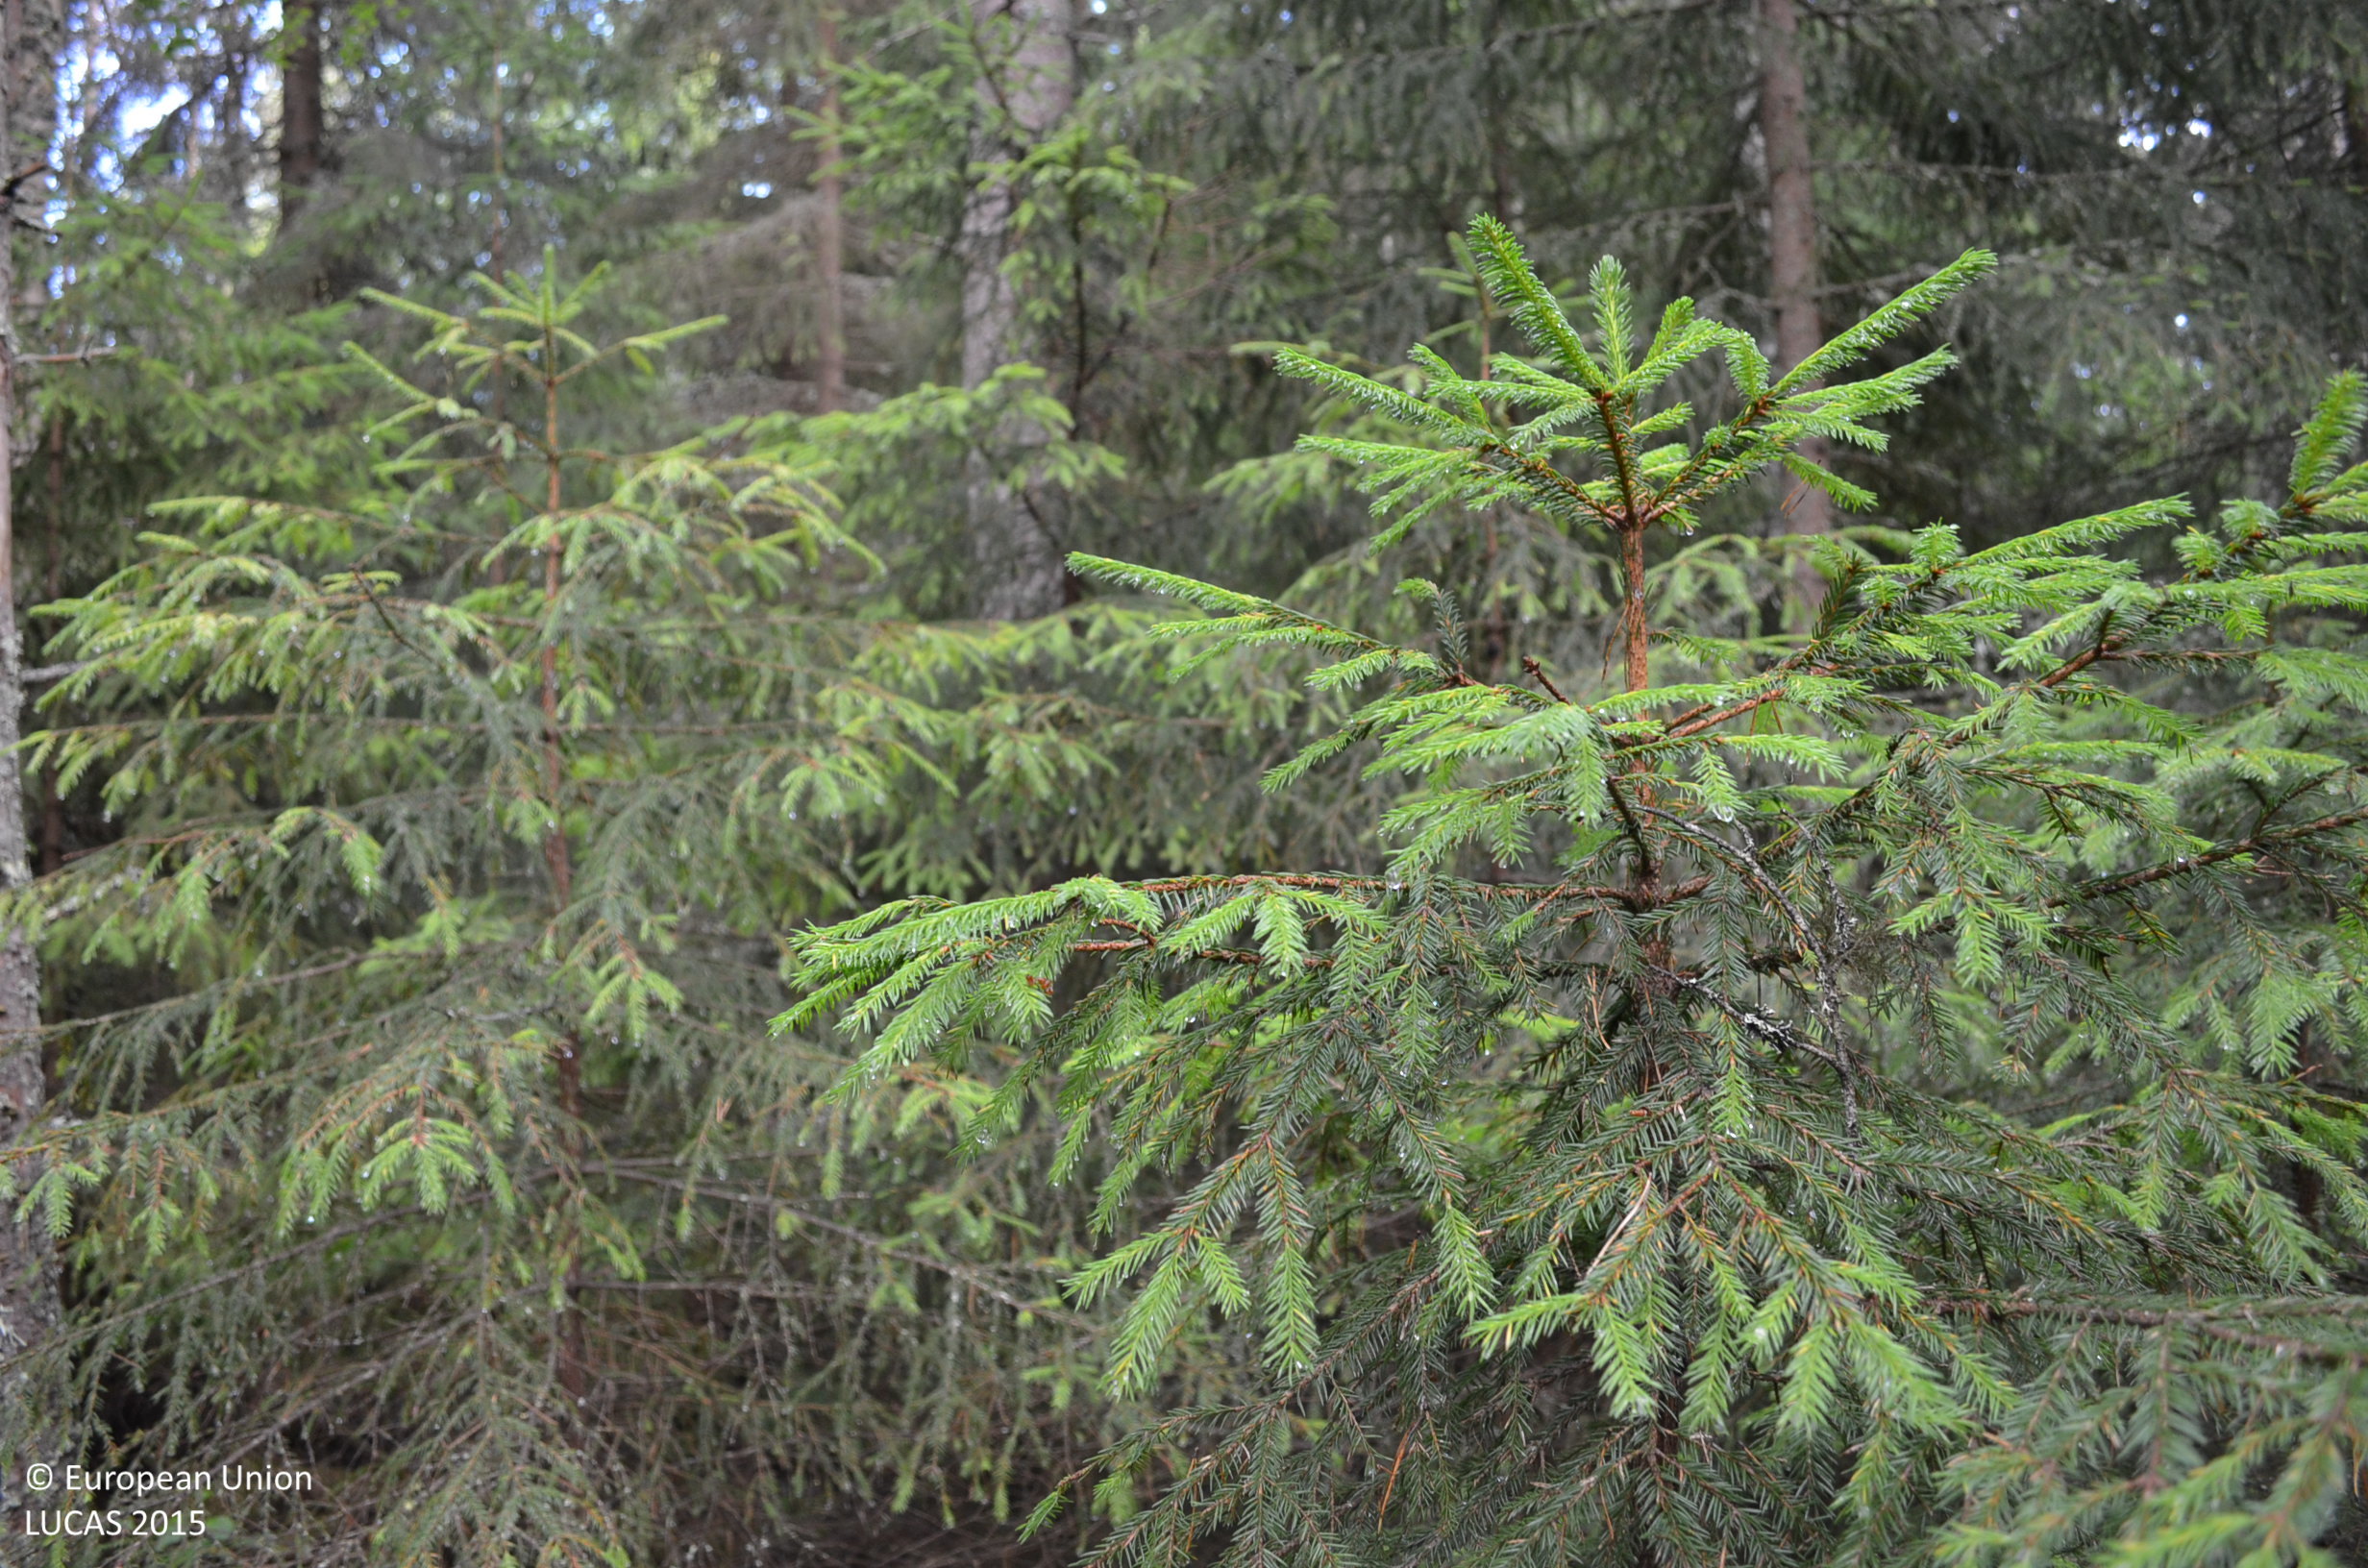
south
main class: Woodland
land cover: Other coniferous woodland
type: boreal forest
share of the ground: > 75 %
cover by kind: coniferous forest trees 85 %, shrubs 10 %, broadleaved forest trees 5 %
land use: Forestry
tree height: > 5 m
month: July
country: FI
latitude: 62.1732
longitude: 23.4185
